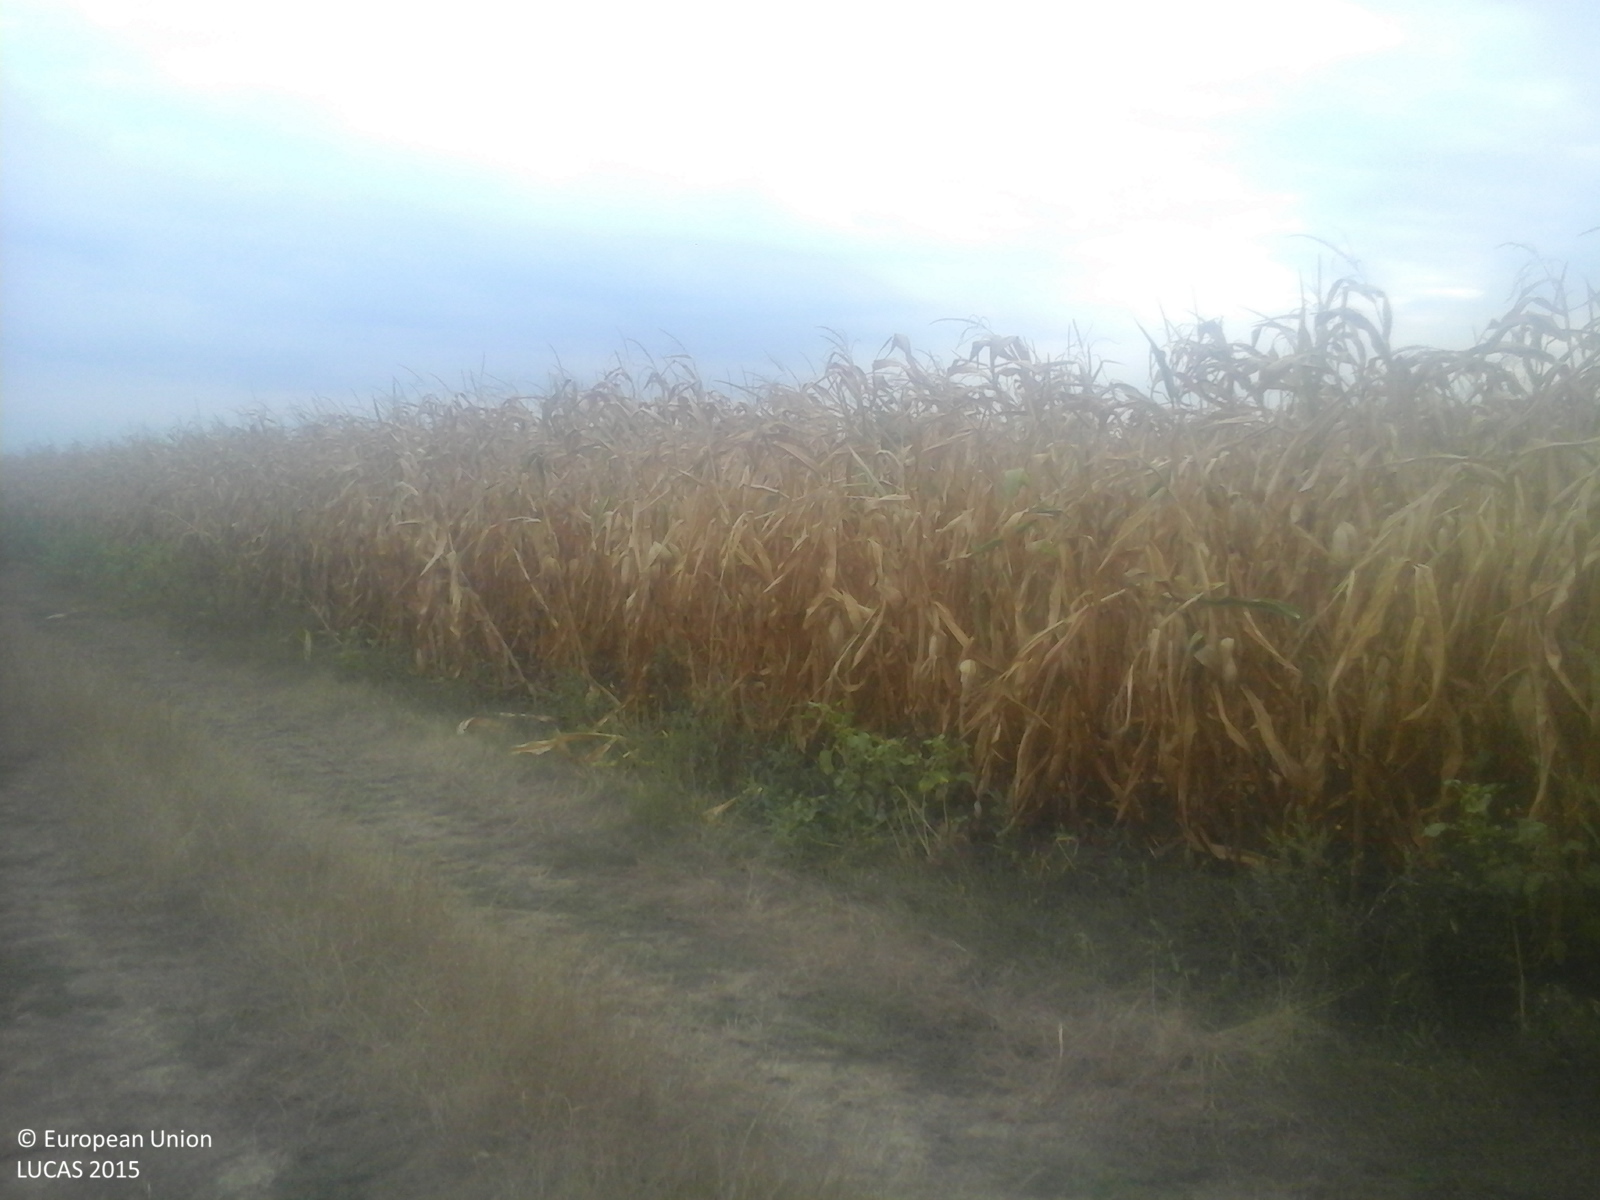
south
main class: Cropland
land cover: Sunflower
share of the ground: > 75 %
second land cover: Spontaneously vegetated surfaces
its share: > 75 %
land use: Agriculture (excluding fallow land and kitchen gardens)
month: September
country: RO
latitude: 47.7415
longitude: 22.6908
